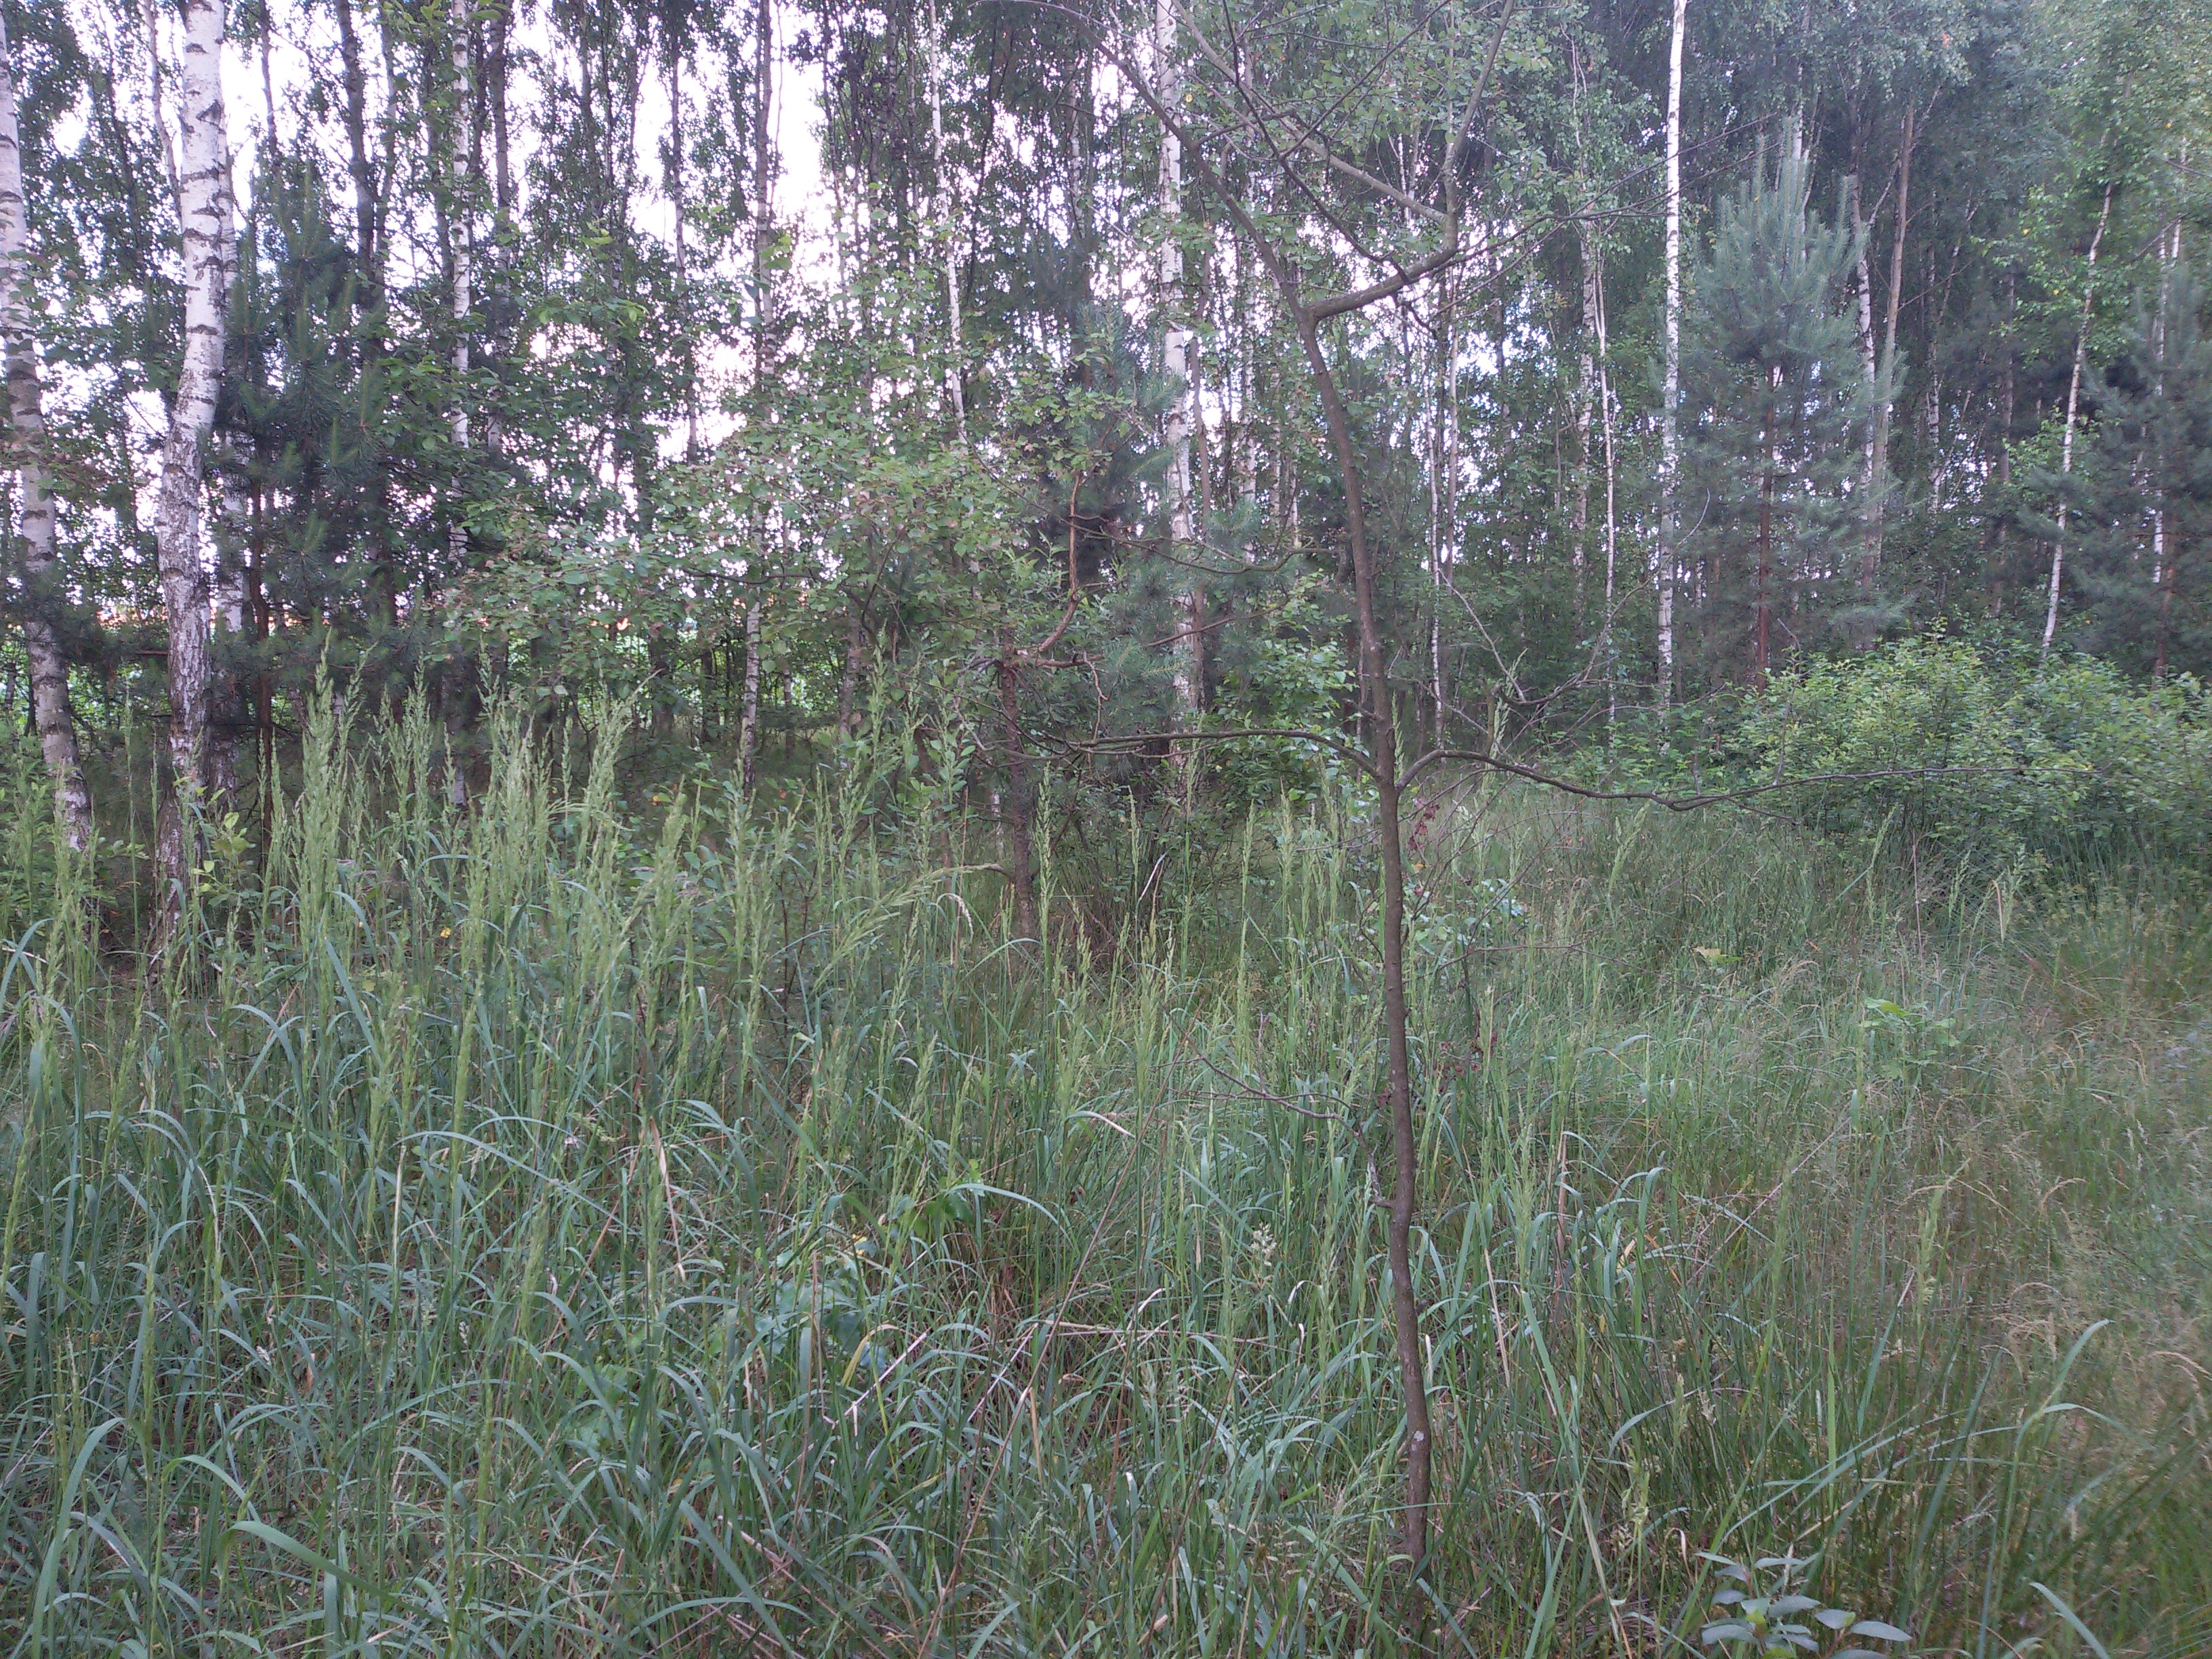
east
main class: Woodland
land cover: Broadleaved woodland
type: mesophytic deciduous forest
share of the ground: > 75 %
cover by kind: broadleaved forest trees 85 %, herbaceous plants 10 %, shrubs 5 %
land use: Forestry
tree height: > 5 m
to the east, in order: Broadleaved woodland; Maize; Barley
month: June
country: PL
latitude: 51.8513
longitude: 23.0697
